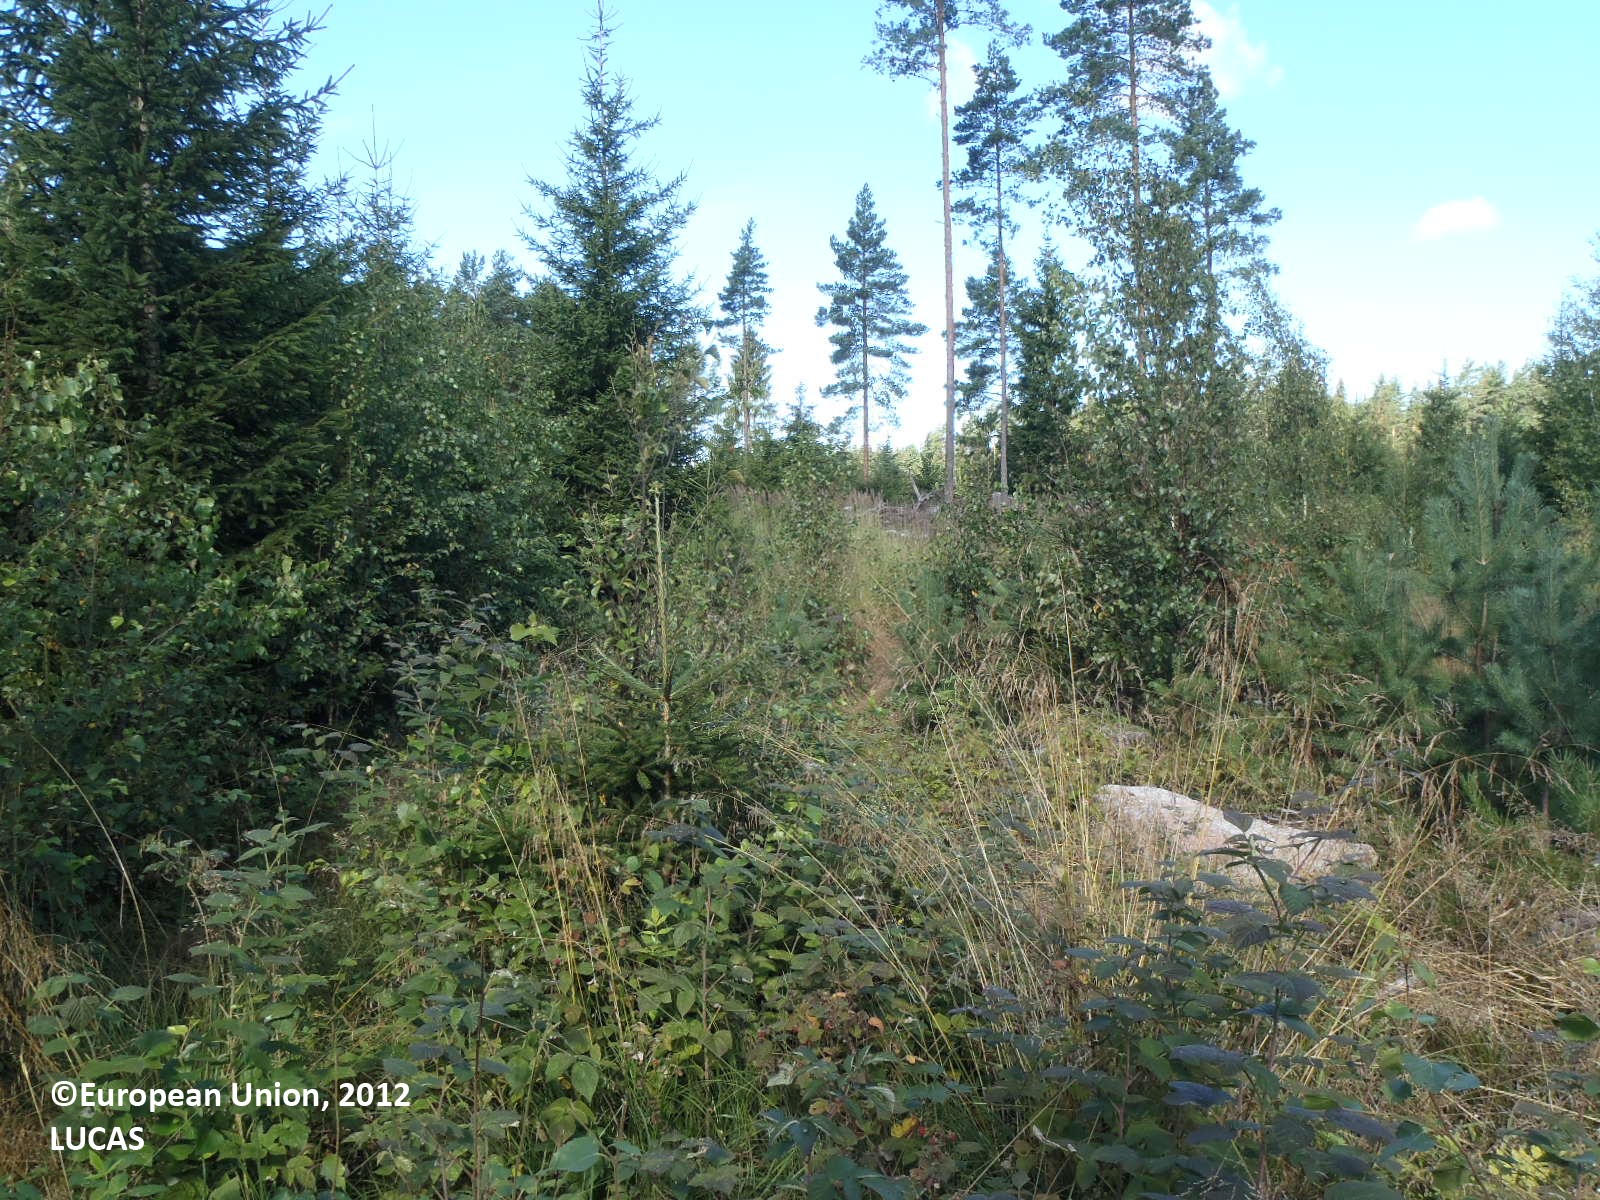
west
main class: Woodland
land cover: Spruce dominated mixed woodland
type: boreal forest
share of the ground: > 75 %
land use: Forestry
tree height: > 5 m
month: August
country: FI
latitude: 60.2455
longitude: 22.2616
